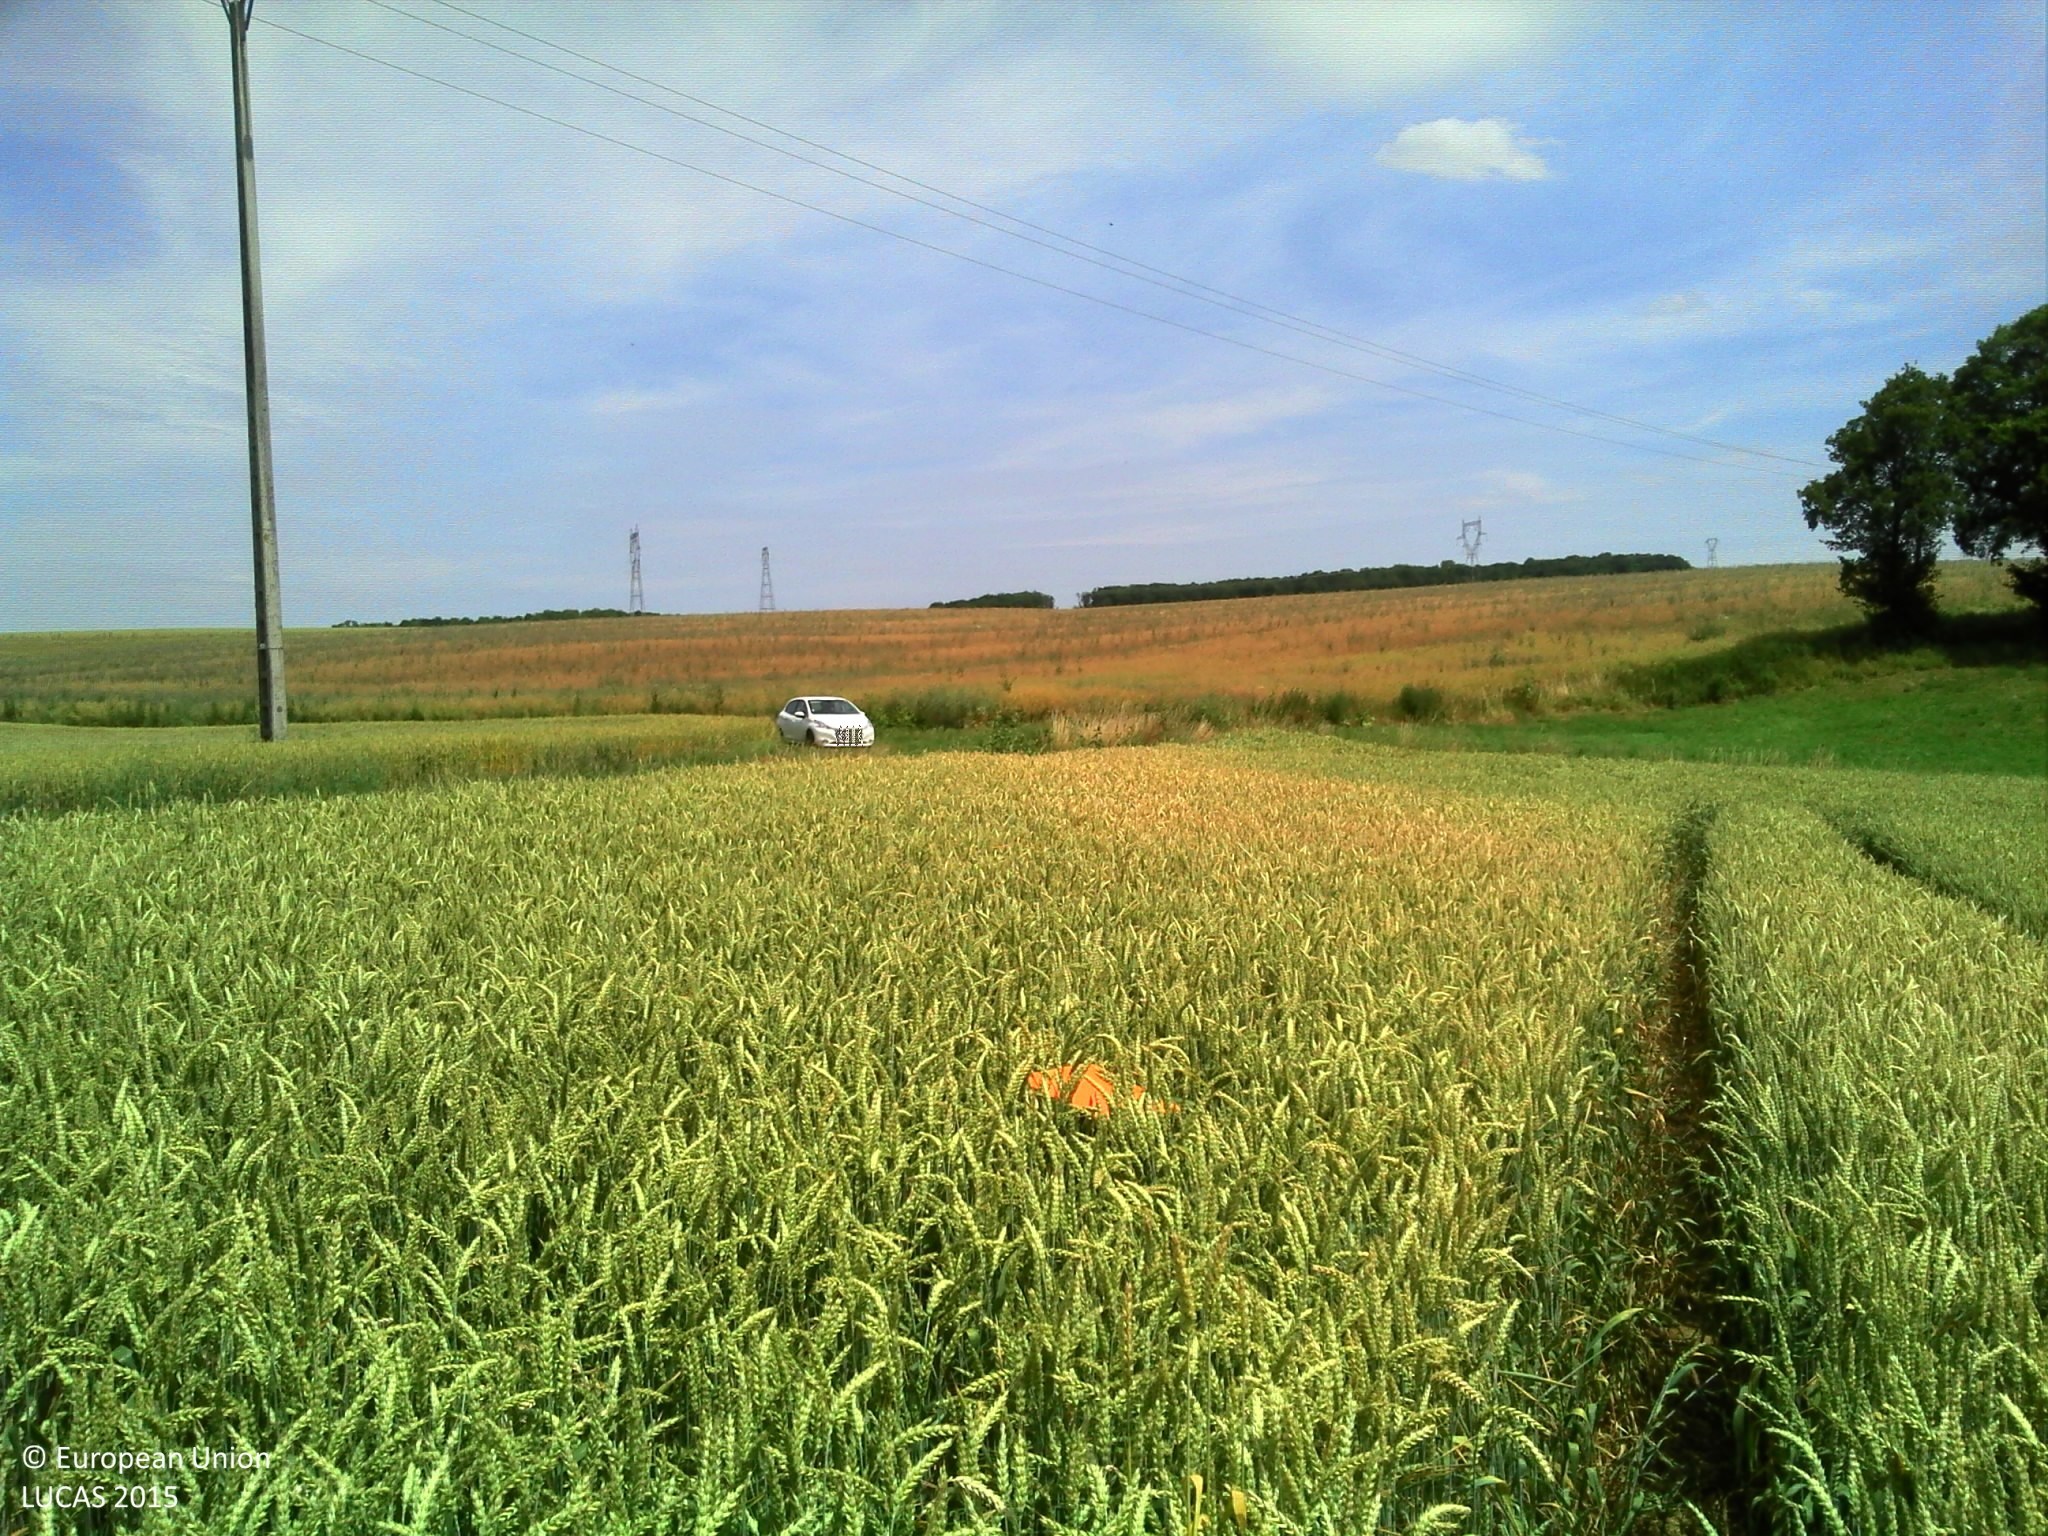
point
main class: Cropland
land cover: Common wheat
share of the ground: > 75 %
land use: Agriculture (excluding fallow land and kitchen gardens)
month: June
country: FR
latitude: 48.4104
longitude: 6.2040
